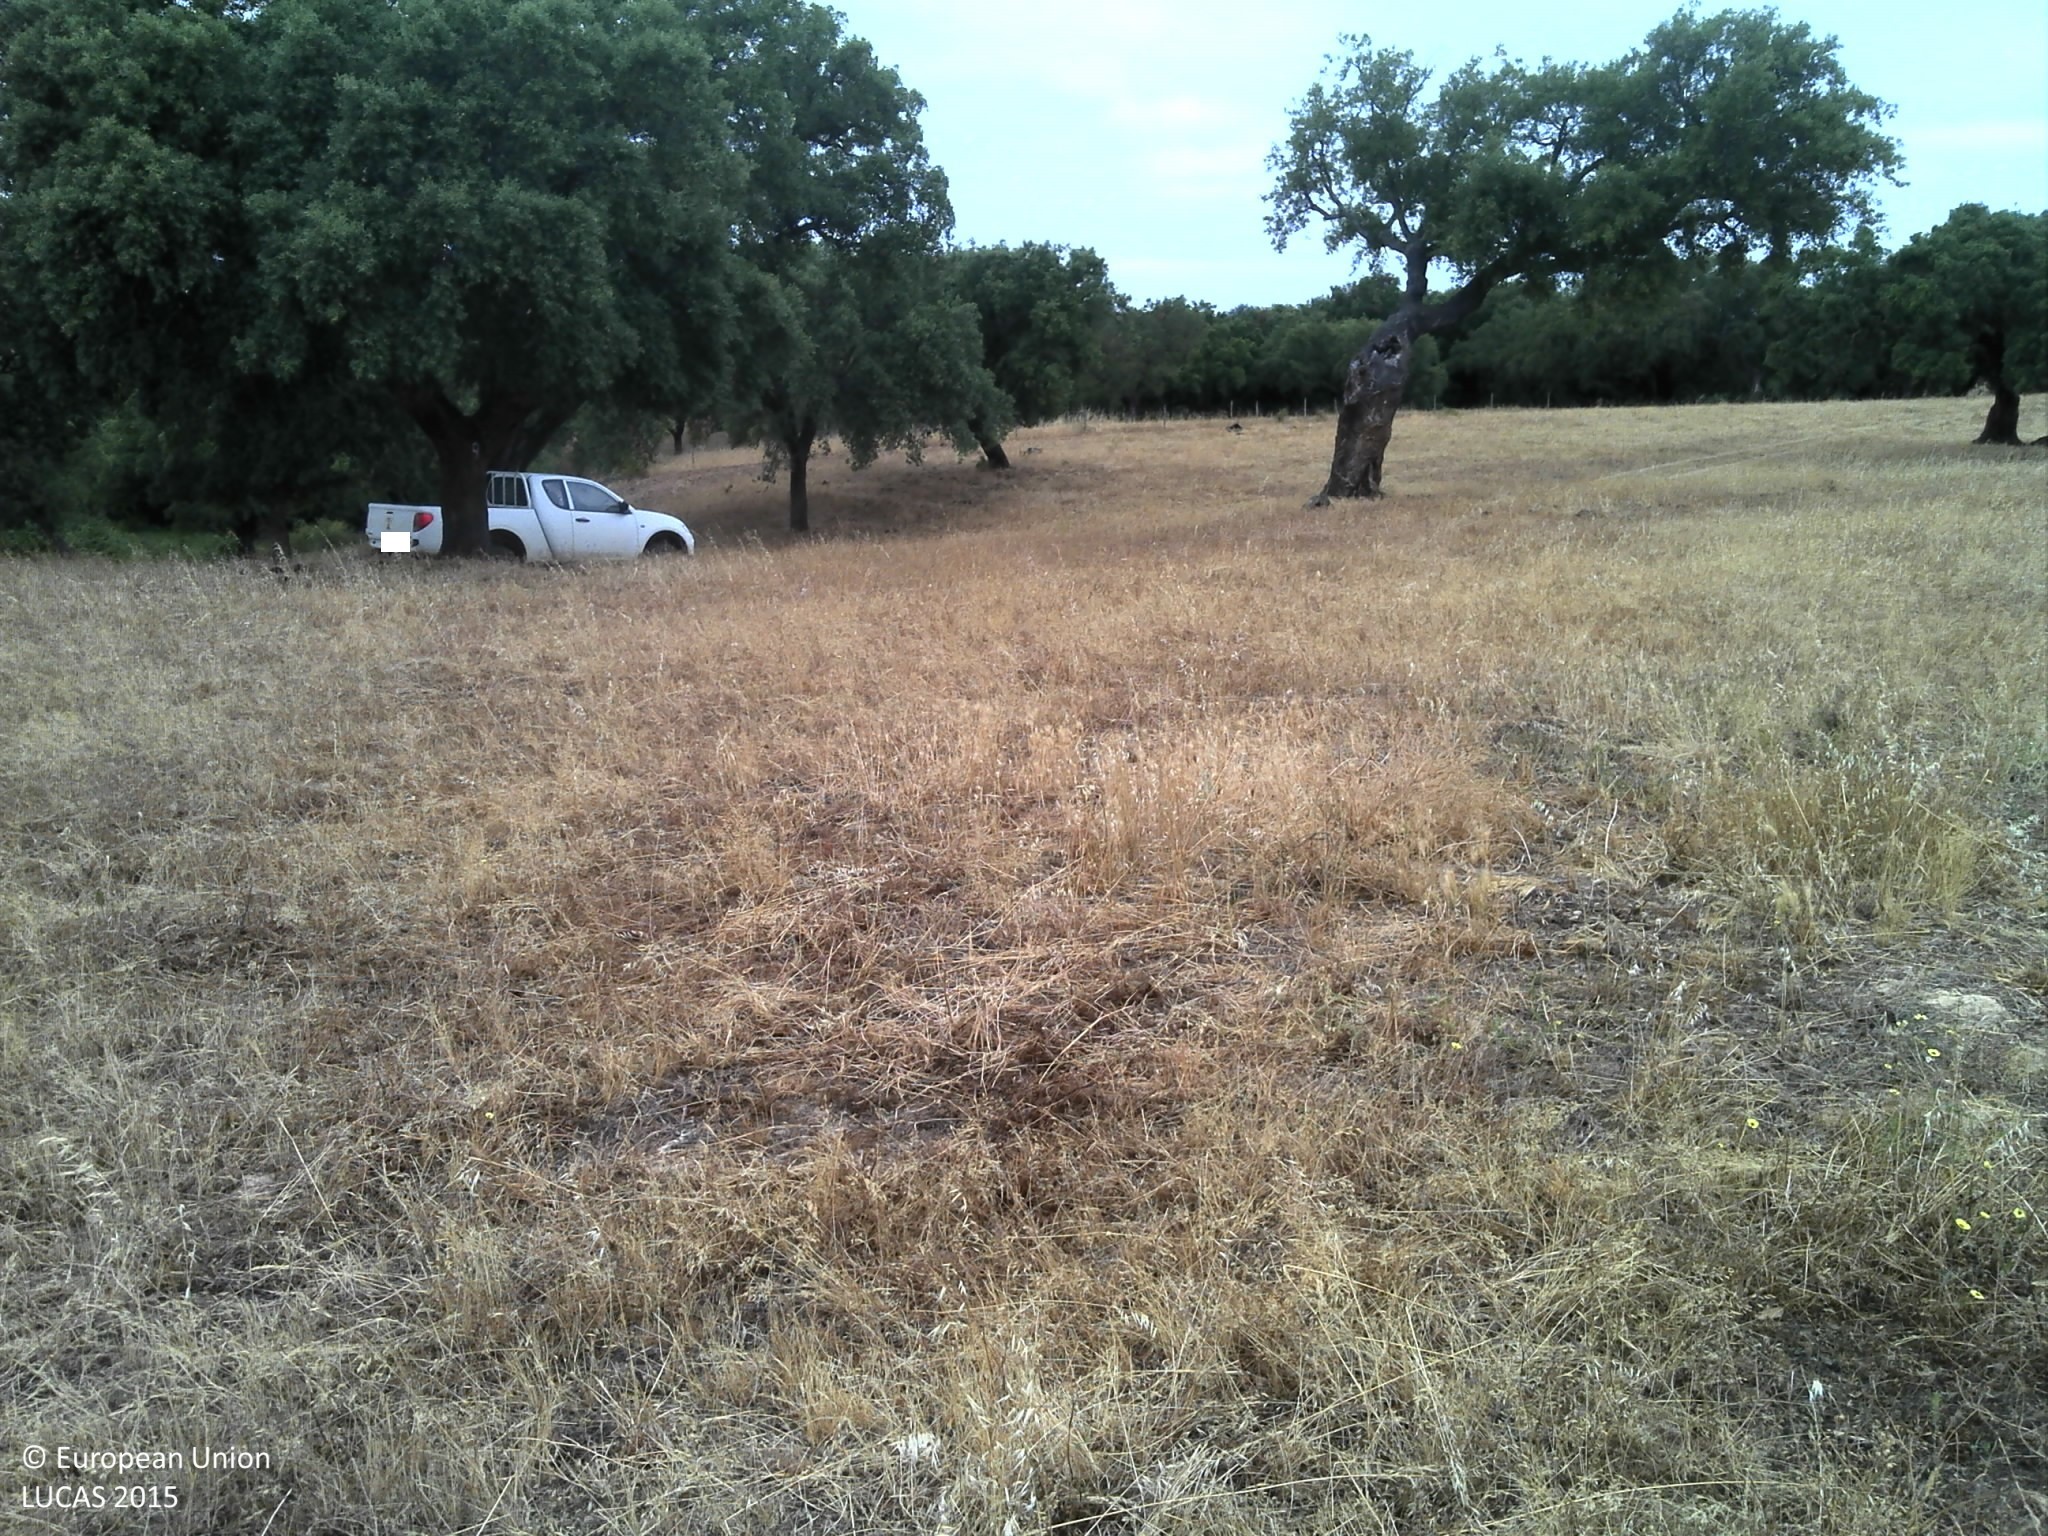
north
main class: Grassland
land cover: Grassland without tree/shrub cover
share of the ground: 50 - 75 %
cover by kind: herbaceous plants 70 %, unconsolidated bare surface 30 %
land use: Agriculture (excluding fallow land and kitchen gardens)
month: June
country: PT
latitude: 37.9991
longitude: -8.3625
